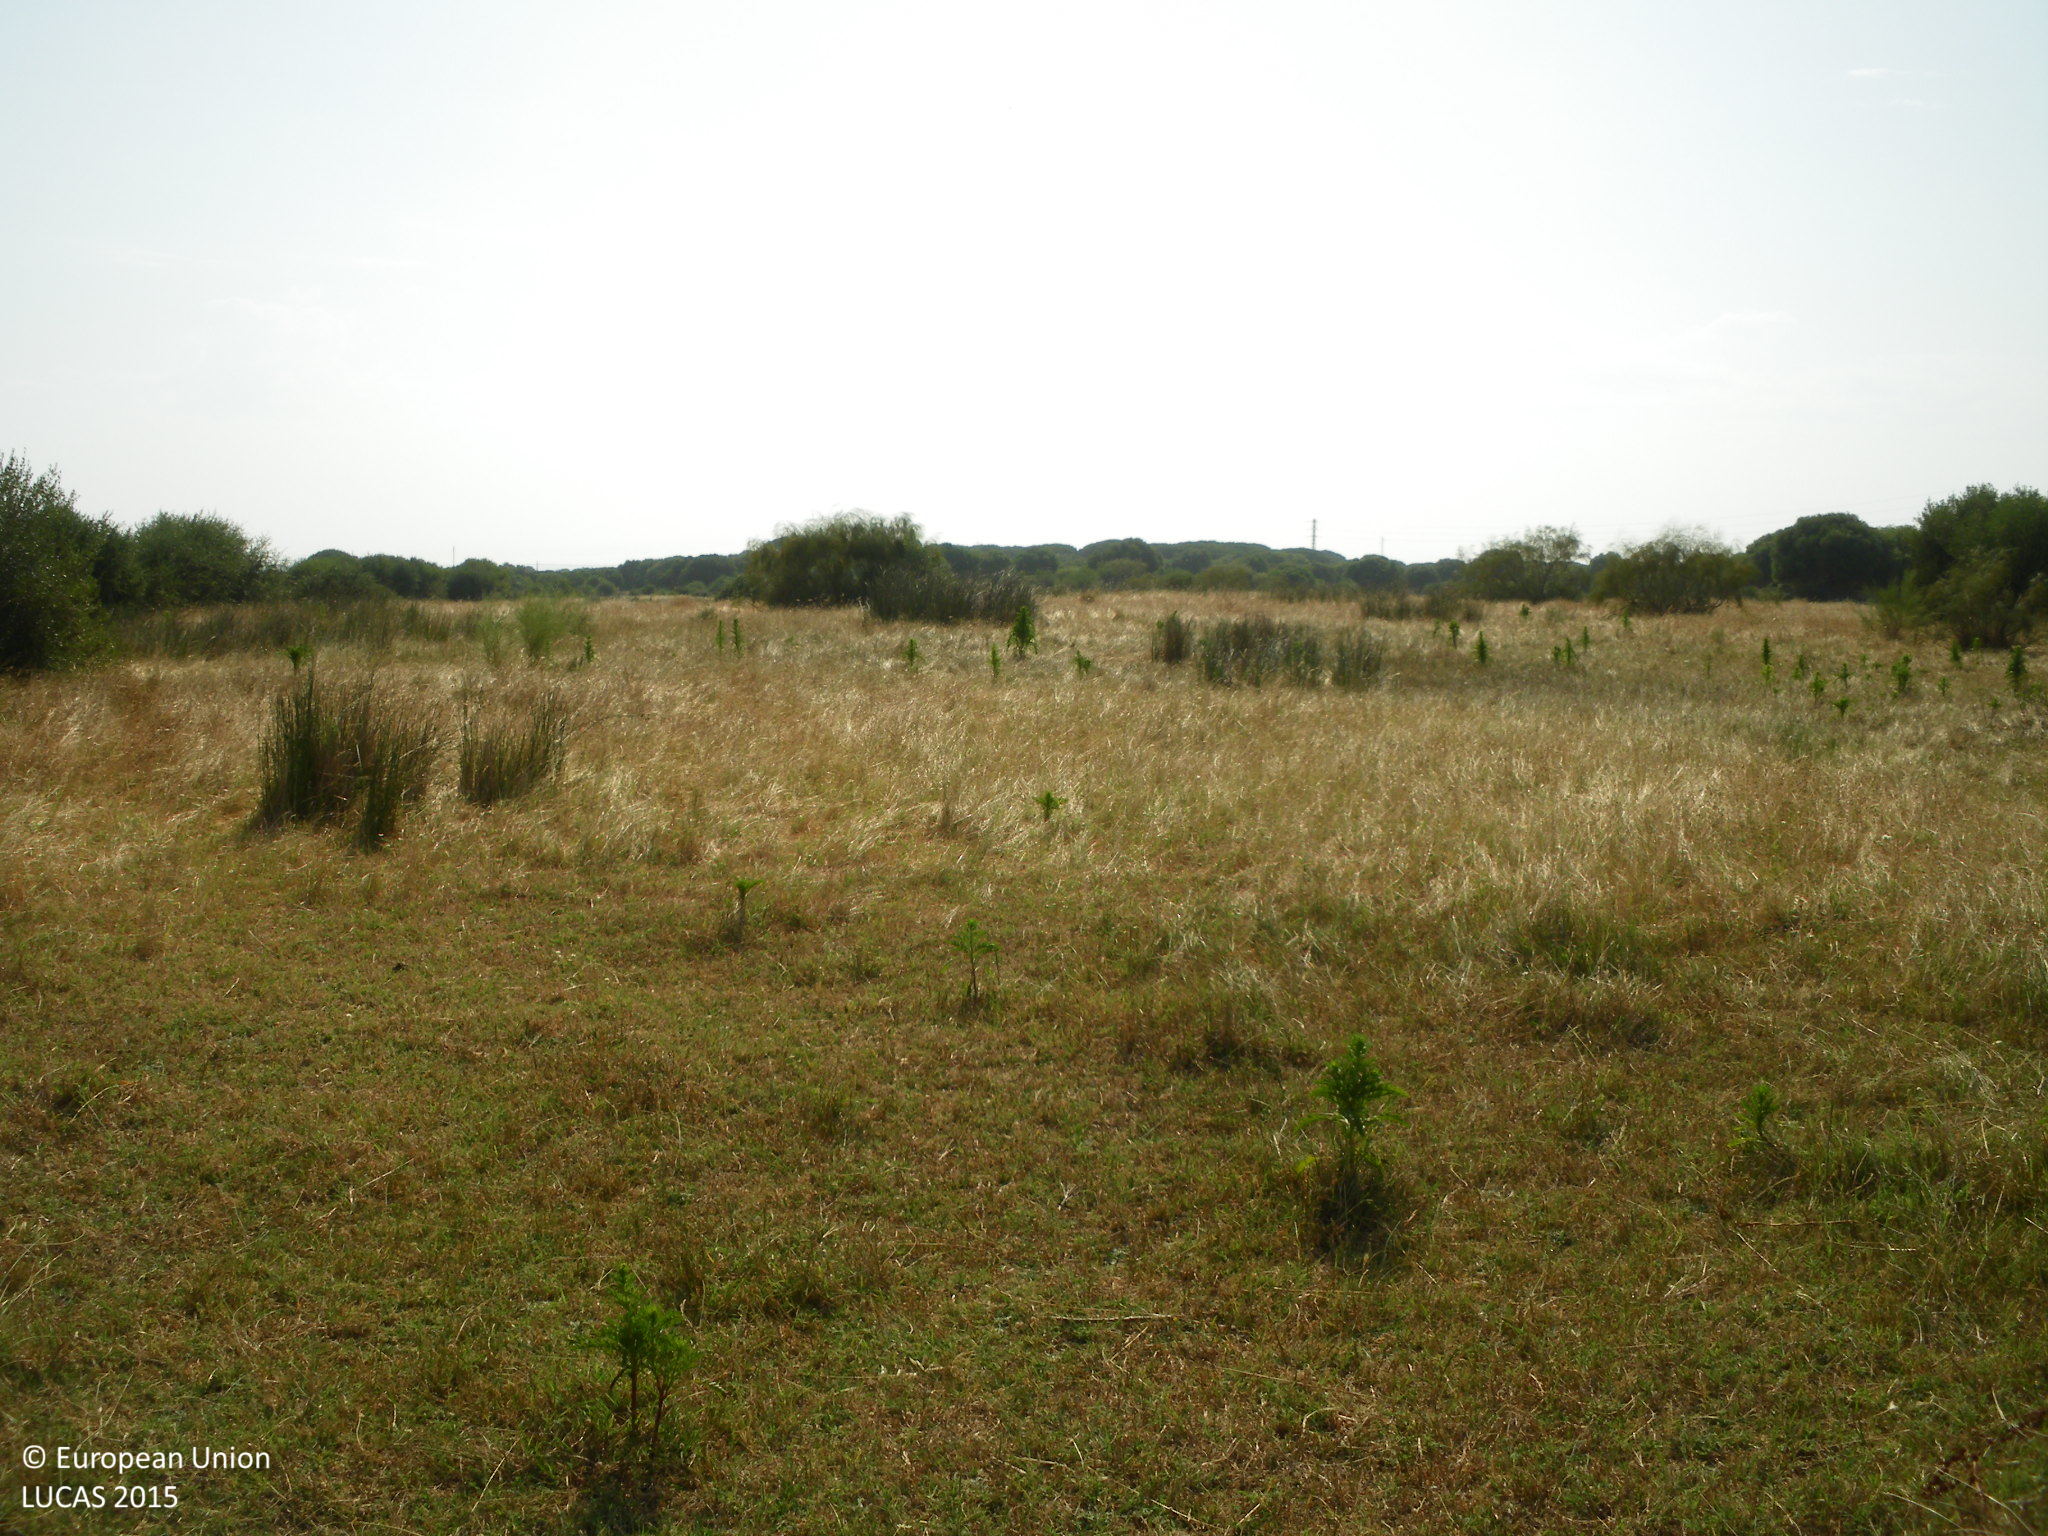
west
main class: Grassland
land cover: Grassland without tree/shrub cover
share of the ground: > 75 %
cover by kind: herbaceous plants 100 %
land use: Agriculture (excluding fallow land and kitchen gardens)
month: June
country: ES
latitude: 36.1943
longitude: -6.0256
